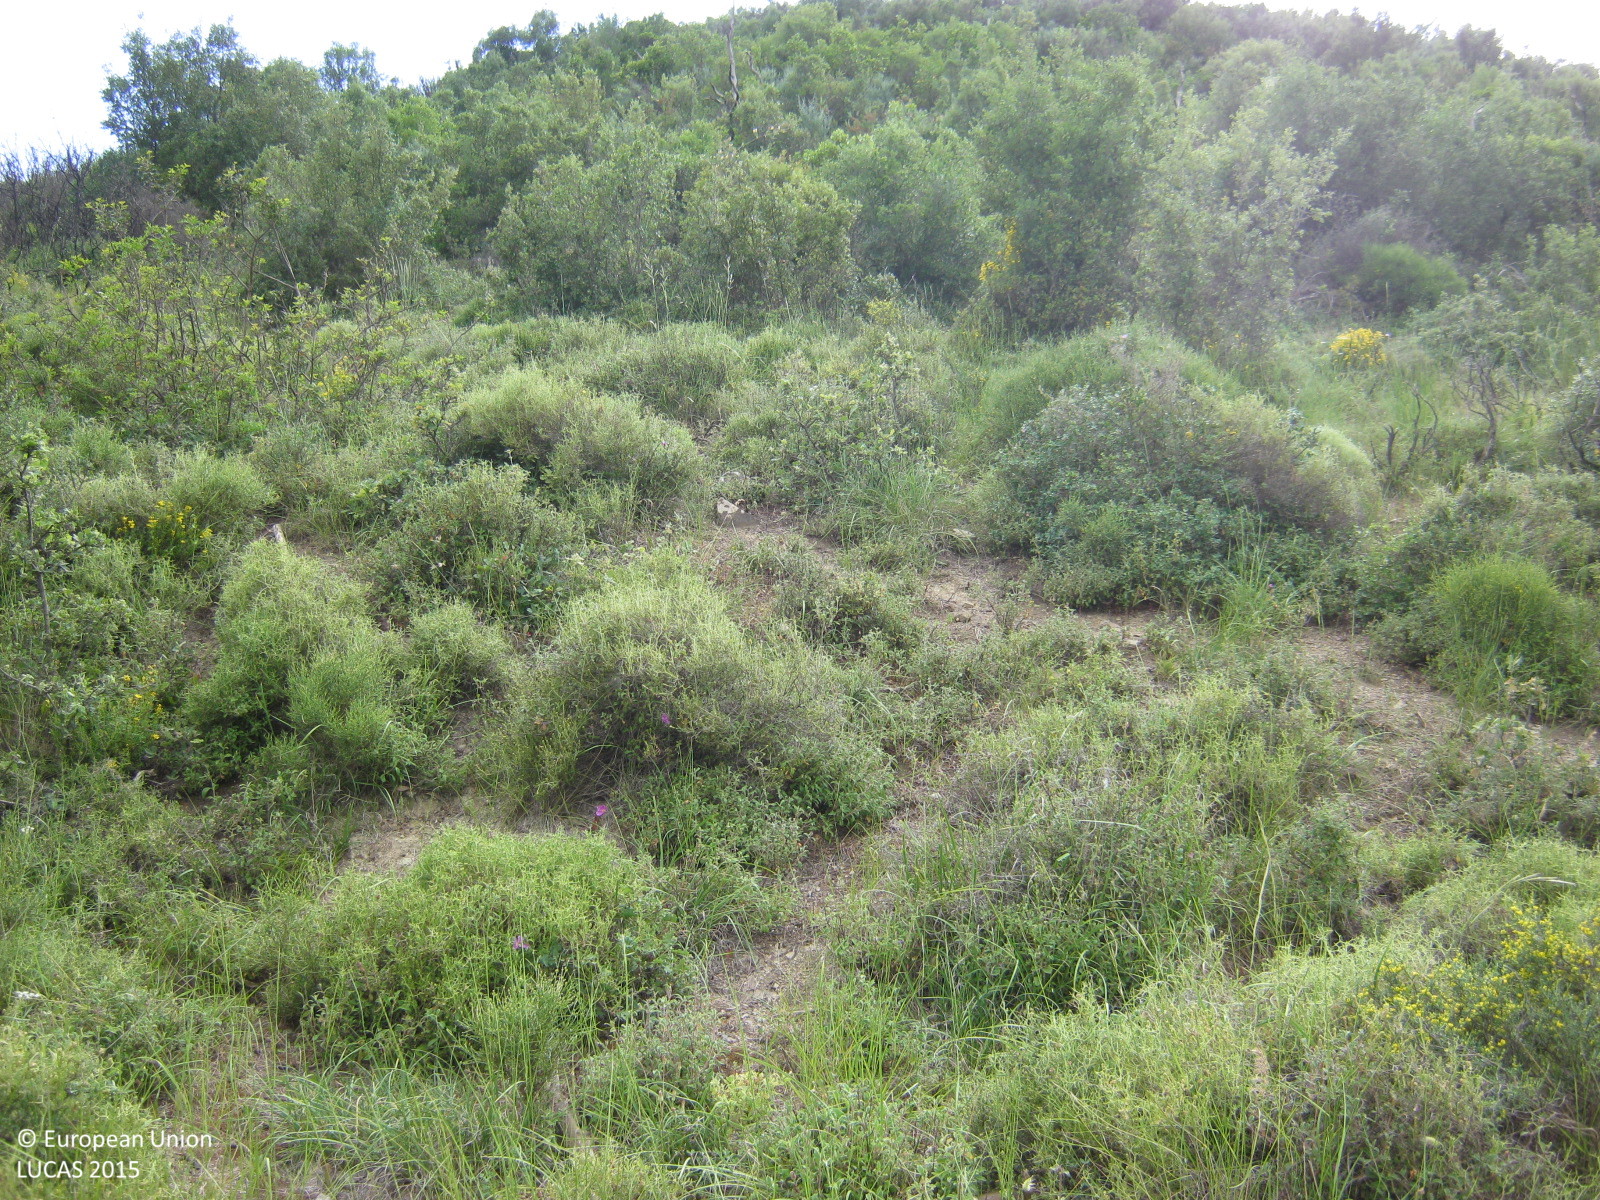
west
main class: Shrubland
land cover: Shrubland with sparse tree cover
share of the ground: > 75 %
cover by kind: shrubs 85 %, herbaceous plants 10 %, broadleaved forest trees 5 %
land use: Semi-natural and natural areas not in use
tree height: < 5 m
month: May
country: GR
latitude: 37.2568
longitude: 22.3040
